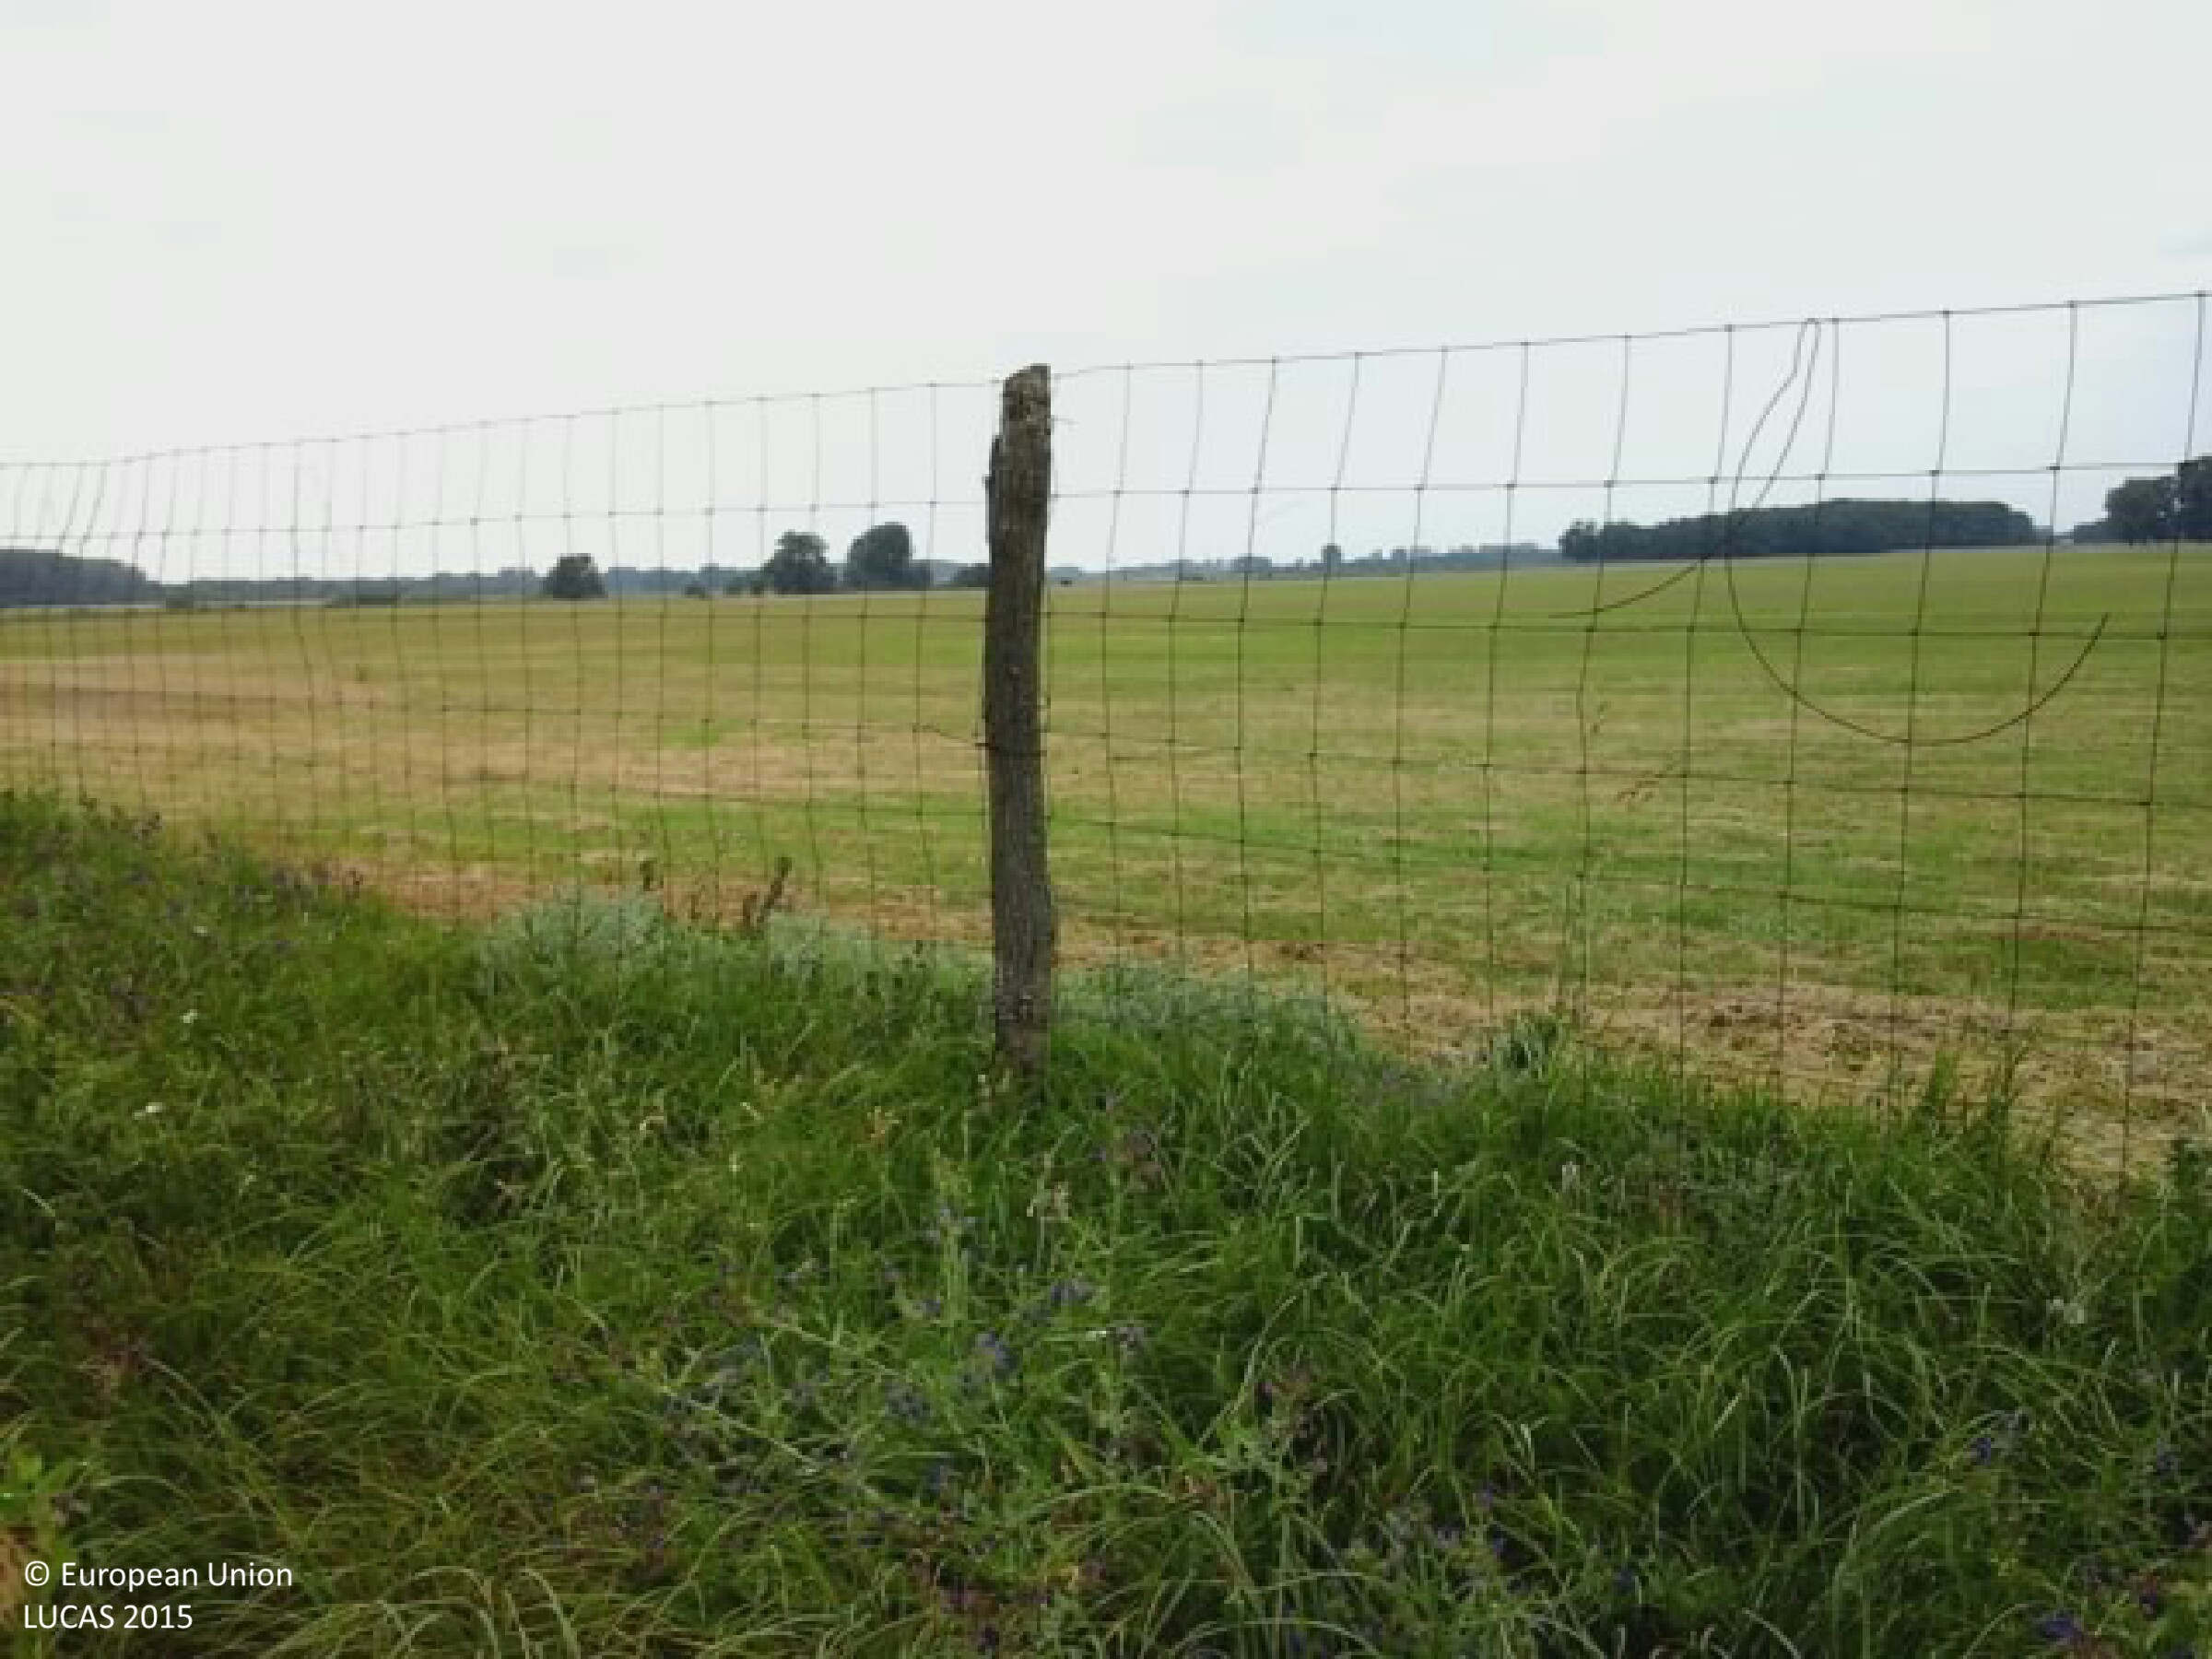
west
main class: Grassland
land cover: Grassland without tree/shrub cover
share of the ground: > 75 %
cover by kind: herbaceous plants 100 %
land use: Agriculture (excluding fallow land and kitchen gardens)
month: June
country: HU
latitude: 47.3765
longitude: 19.3036
